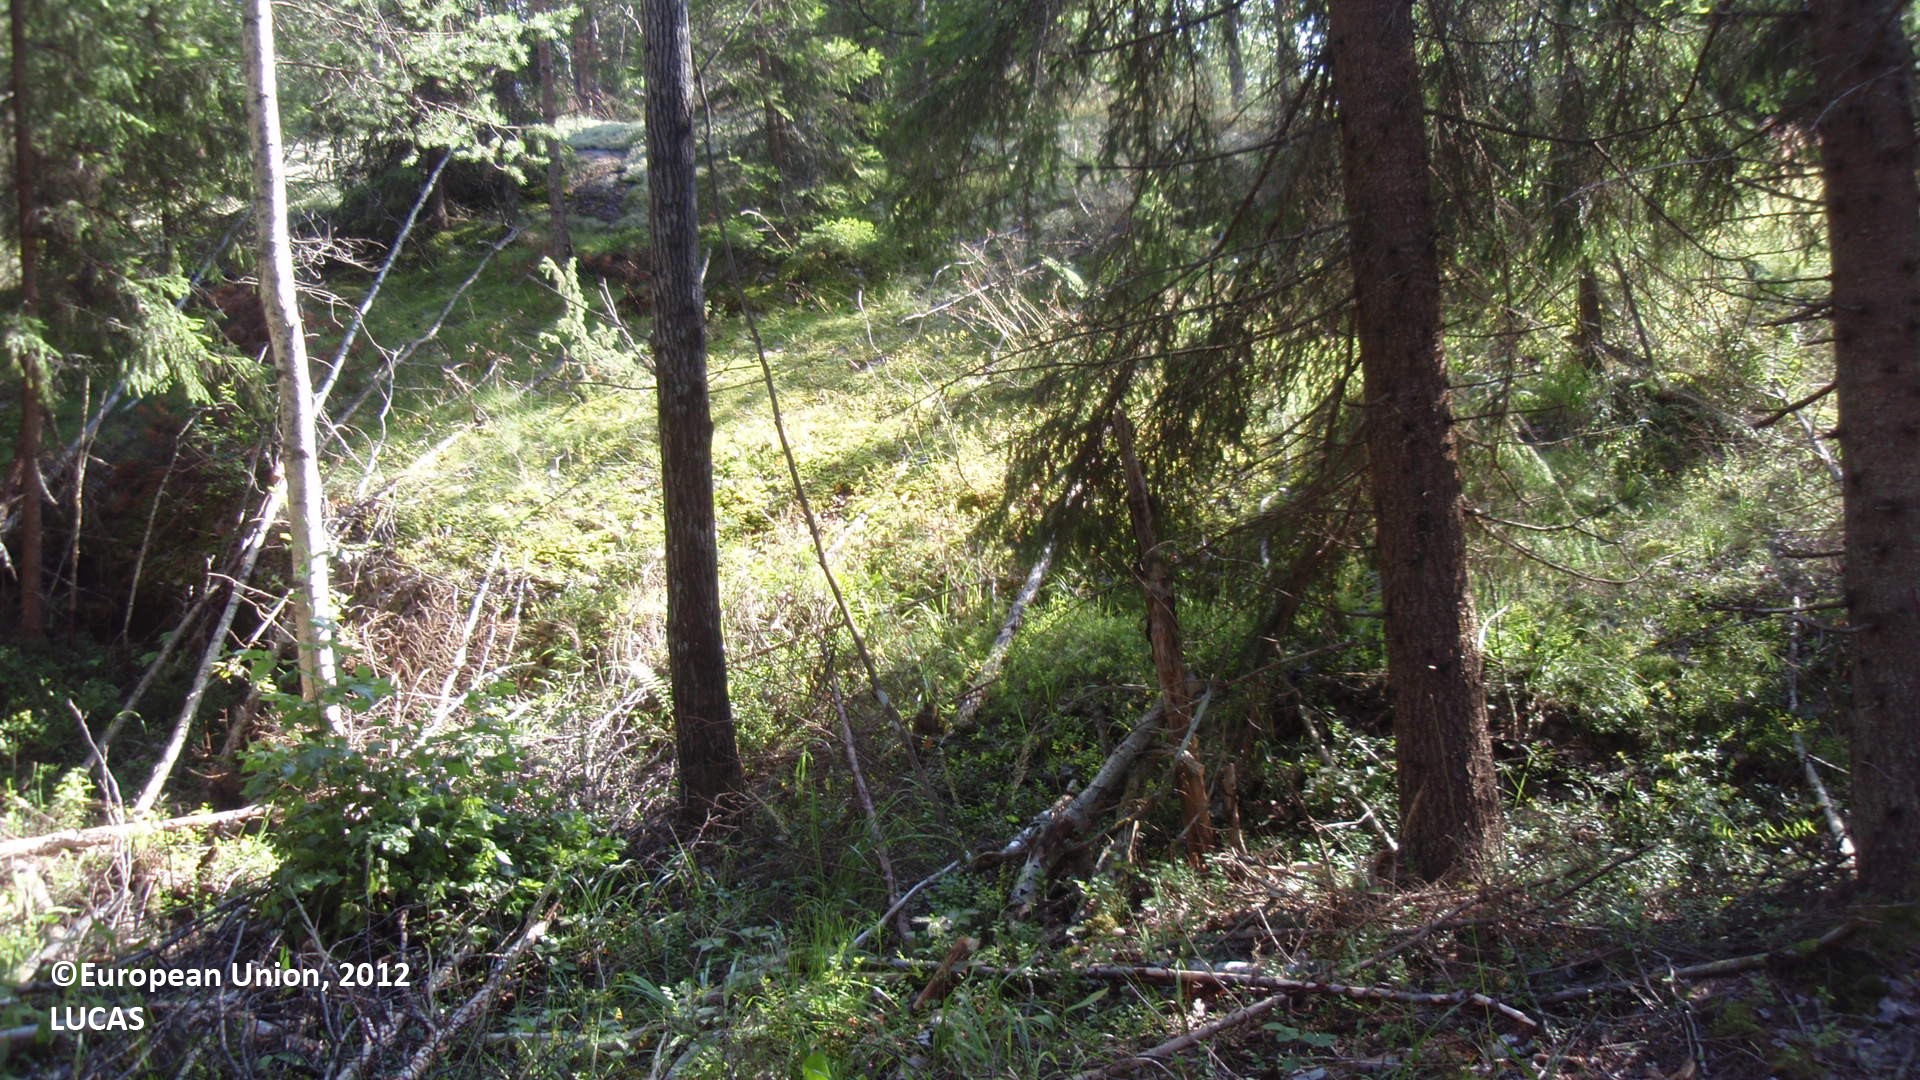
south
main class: Woodland
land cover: Spruce dominated mixed woodland
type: boreal forest
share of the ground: 25 - 50 %
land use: Forestry
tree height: > 5 m
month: July
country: FI
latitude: 61.1121
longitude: 28.2239
